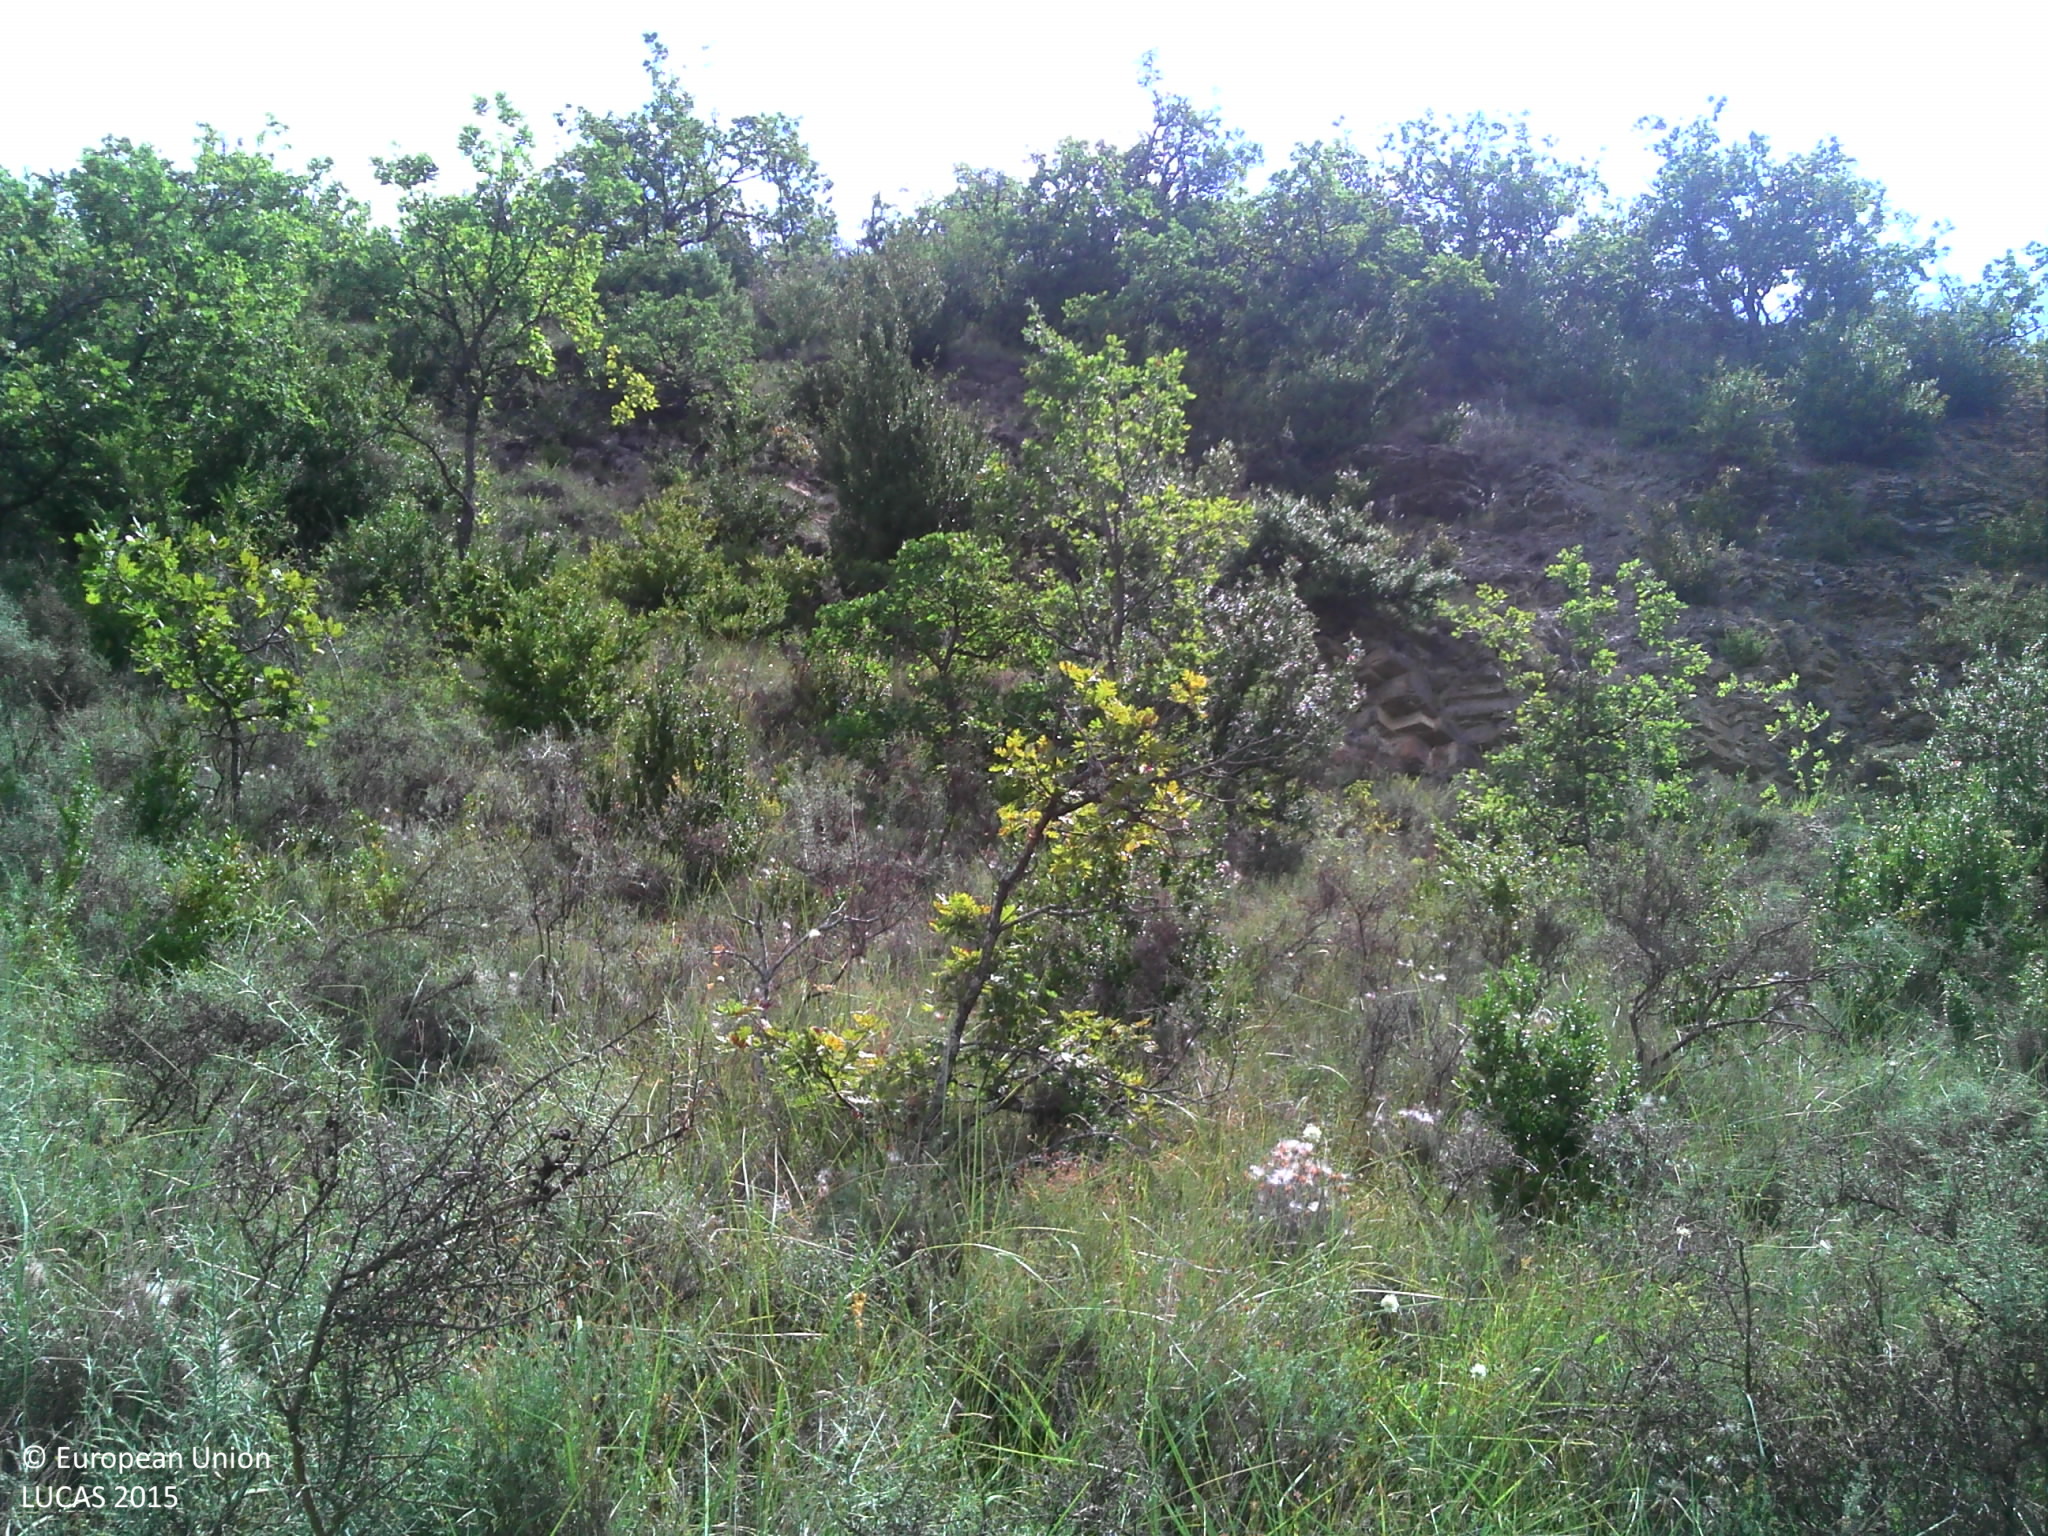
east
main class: Woodland
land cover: Broadleaved woodland
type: broadleaved evergreen forest
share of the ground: > 75 %
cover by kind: broadleaved forest trees 100 %
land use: Semi-natural and natural areas not in use
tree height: > 5 m
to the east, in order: Broadleaved woodland; Rocks and stones; Broadleaved woodland; Rocks and stones; Grassland with sparse tree/shrub cover
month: July
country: FR
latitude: 44.7373
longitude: 4.6643
